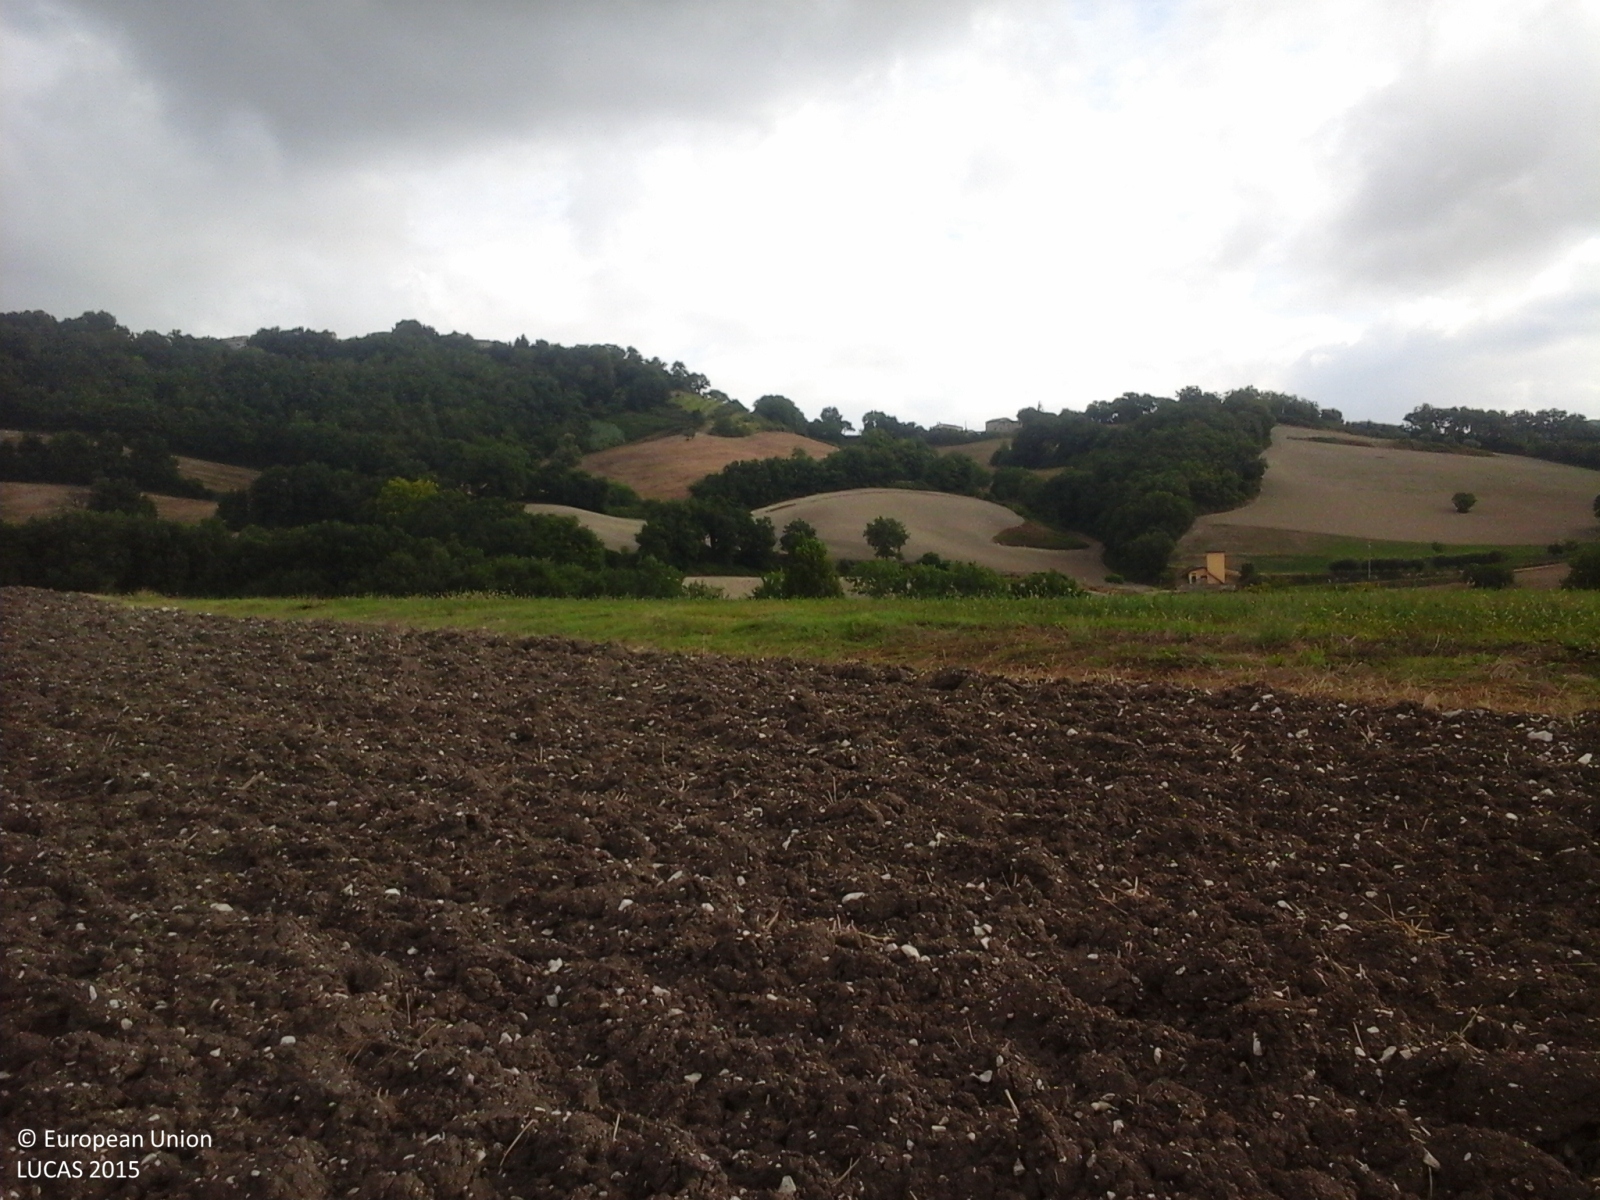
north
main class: Cropland
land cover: Durum wheat
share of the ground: < 10 %
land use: Agriculture (excluding fallow land and kitchen gardens)
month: August
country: IT
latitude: 43.5893
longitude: 12.8540
